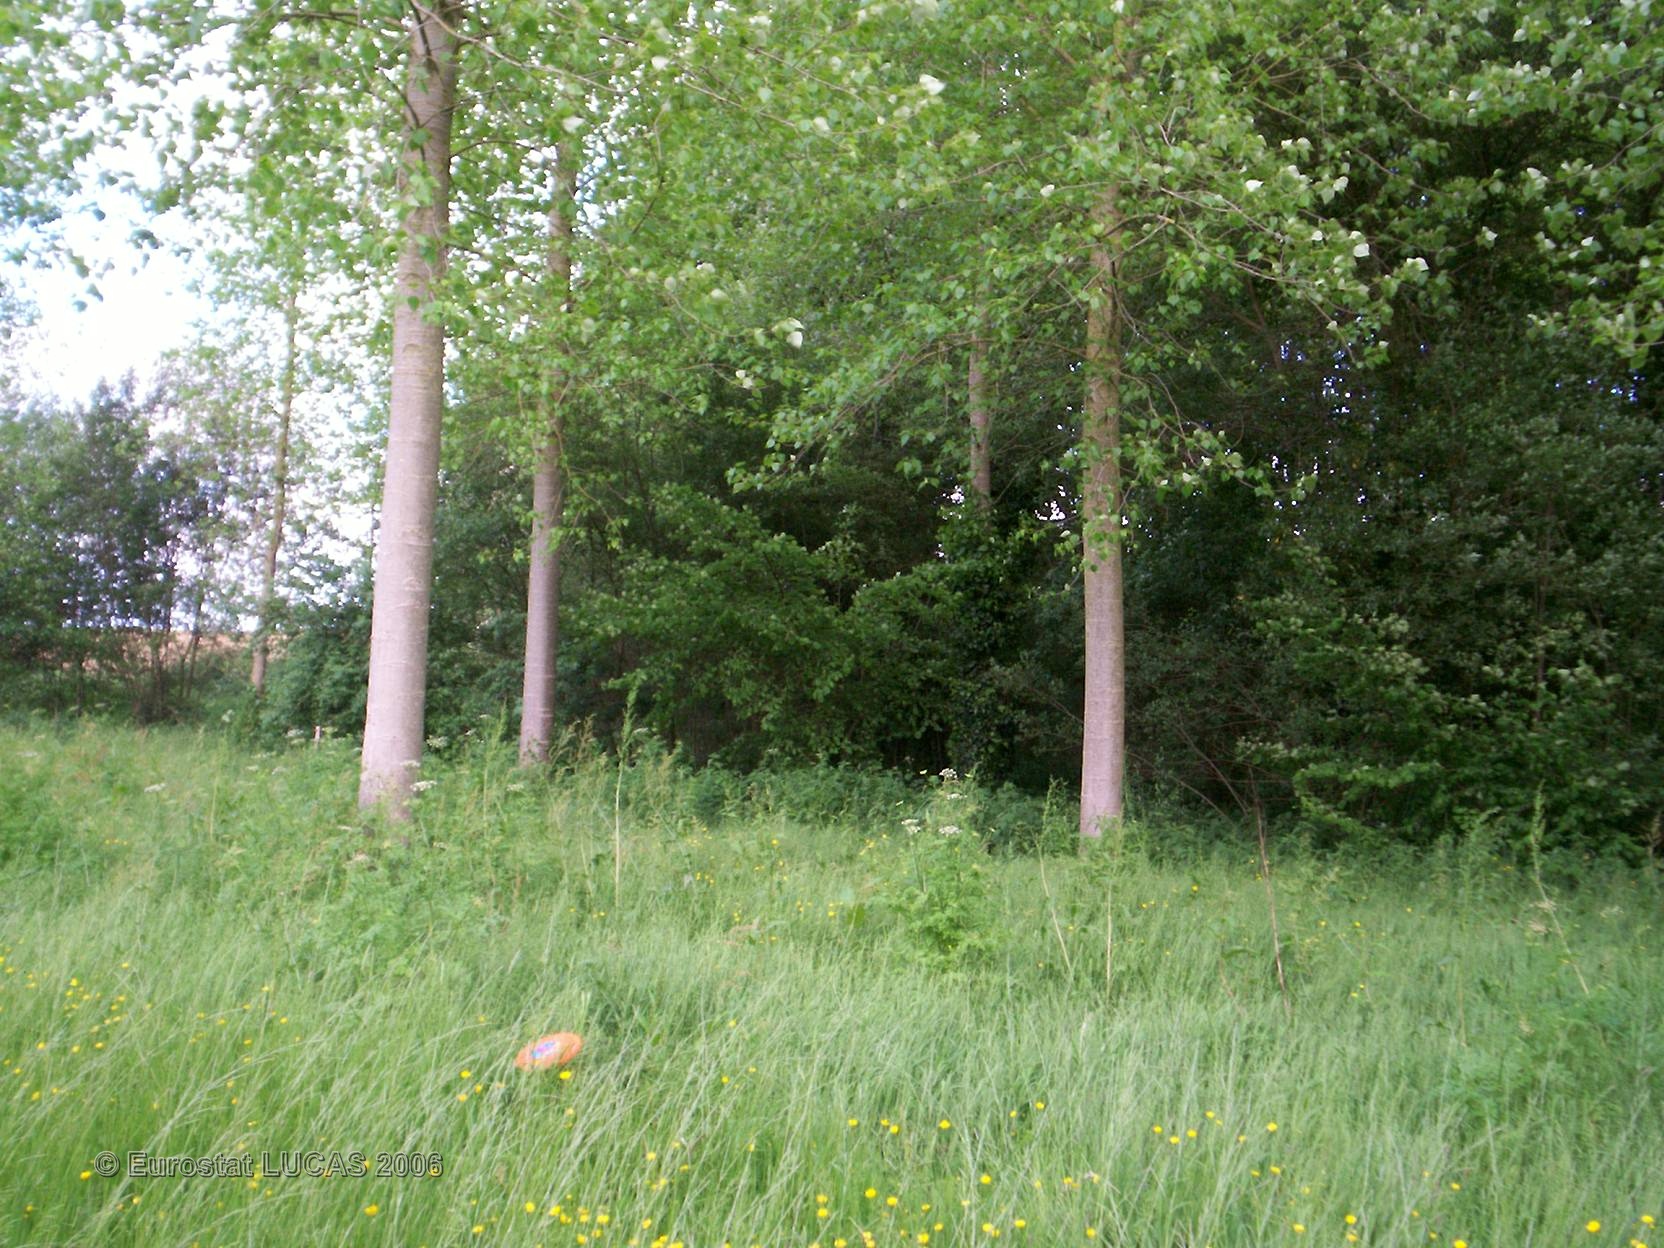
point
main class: Woodland
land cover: Broadleaved forest
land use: Forestry
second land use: Wetland
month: May
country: FR
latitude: 48.4214
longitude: -2.4794
